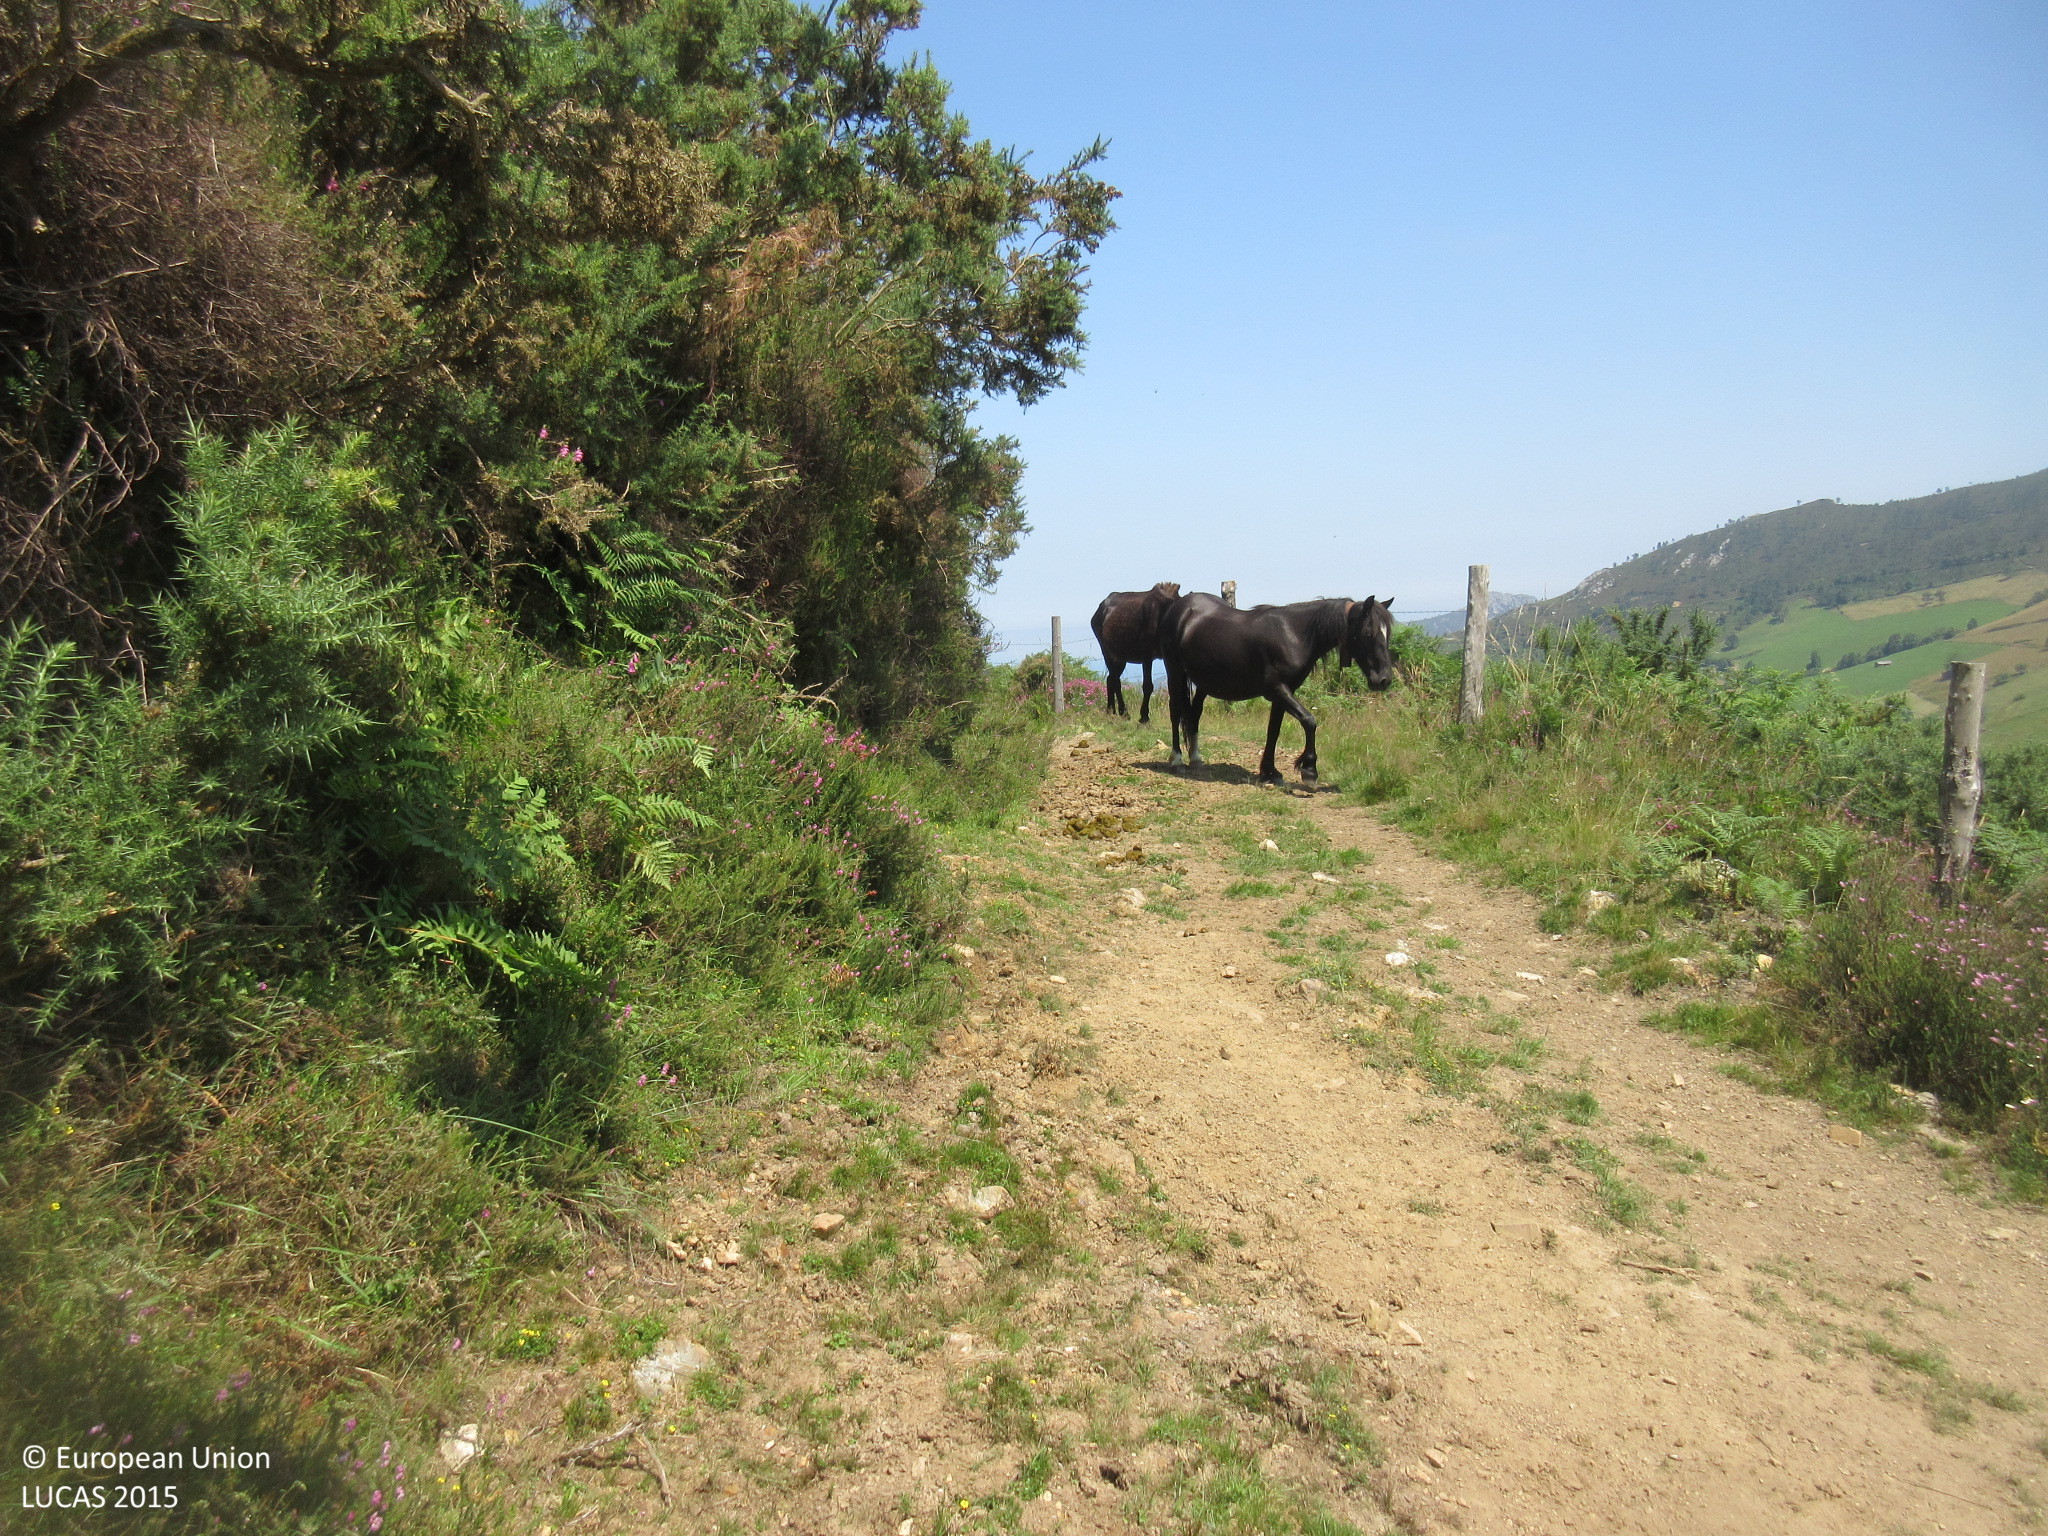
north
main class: Shrubland
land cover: Shrubland without tree cover
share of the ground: > 75 %
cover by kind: shrubs 100 %
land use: Agriculture (excluding fallow land and kitchen gardens)
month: July
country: ES
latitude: 43.4312
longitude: -6.6742
